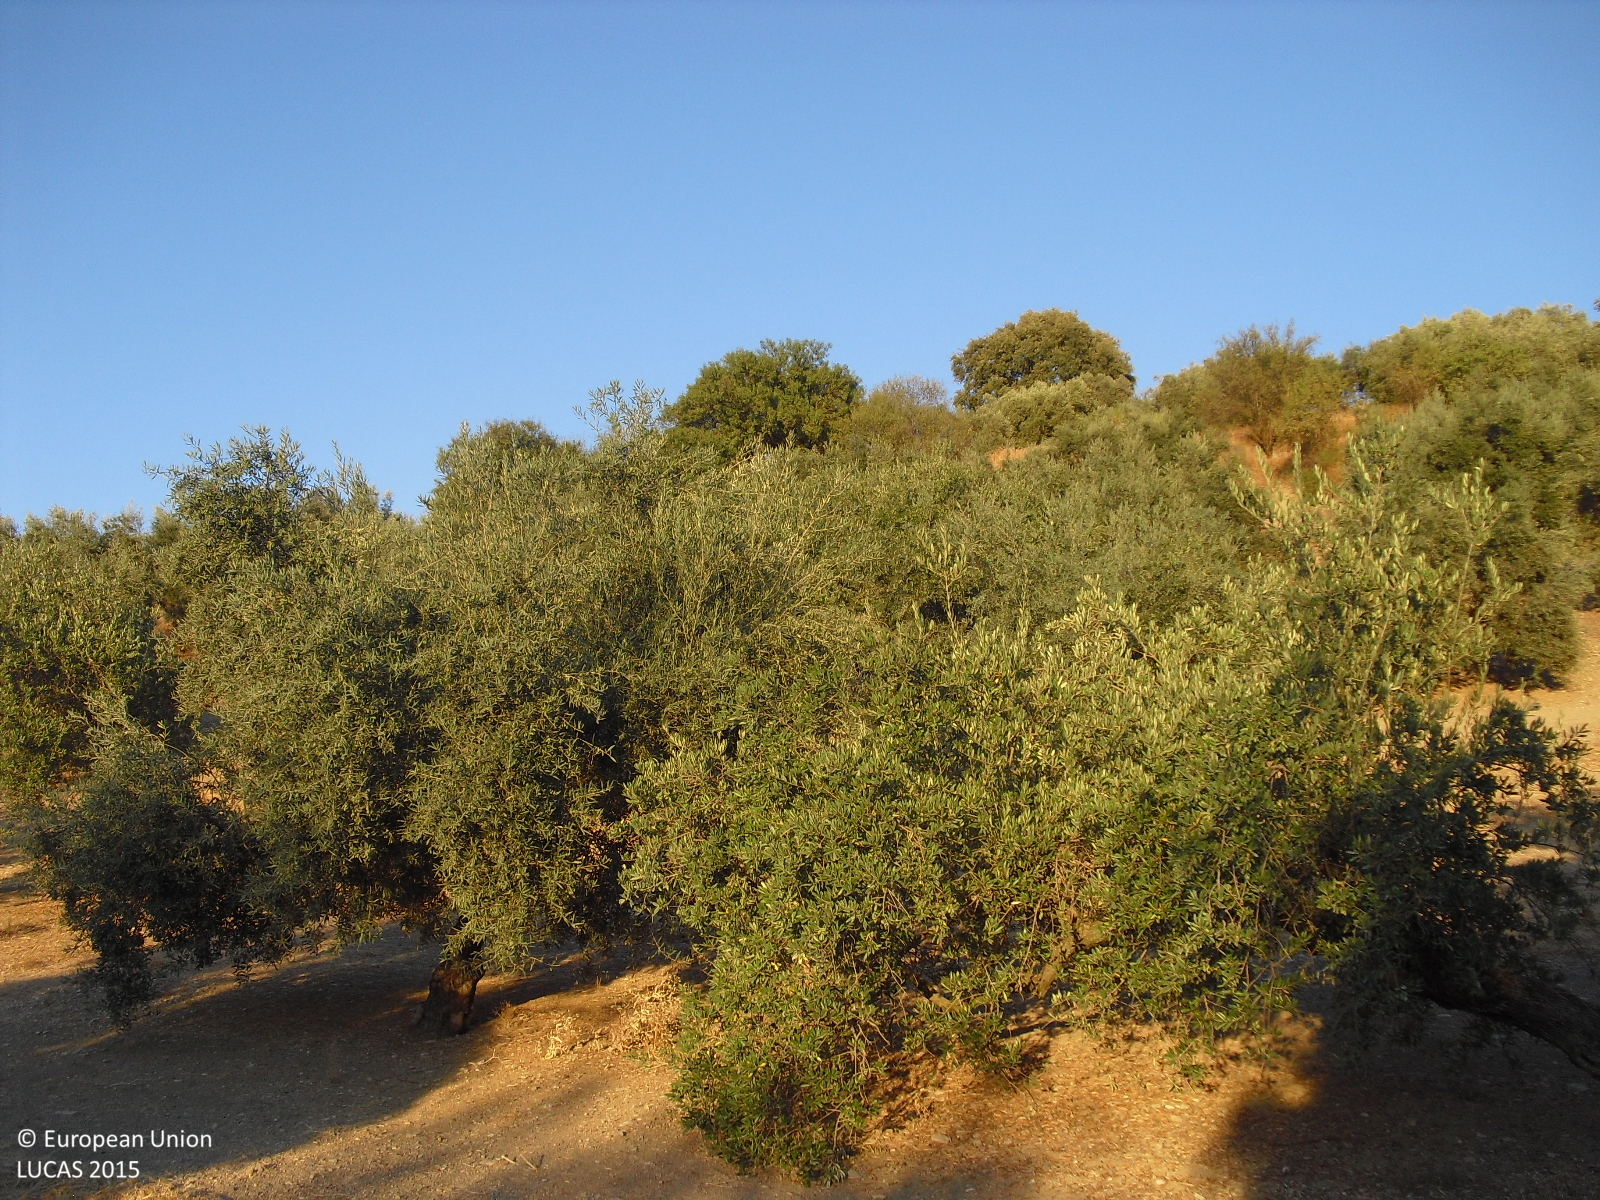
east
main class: Cropland
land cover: Olive groves
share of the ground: 25 - 50 %
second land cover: Other bare soil
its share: > 75 %
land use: Agriculture (excluding fallow land and kitchen gardens)
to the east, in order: Olive groves; Other bare soil; Lines of trees; Olive groves; Broadleaved woodland; Olive groves; Common wheat
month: August
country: ES
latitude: 37.2396
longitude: -4.1200
